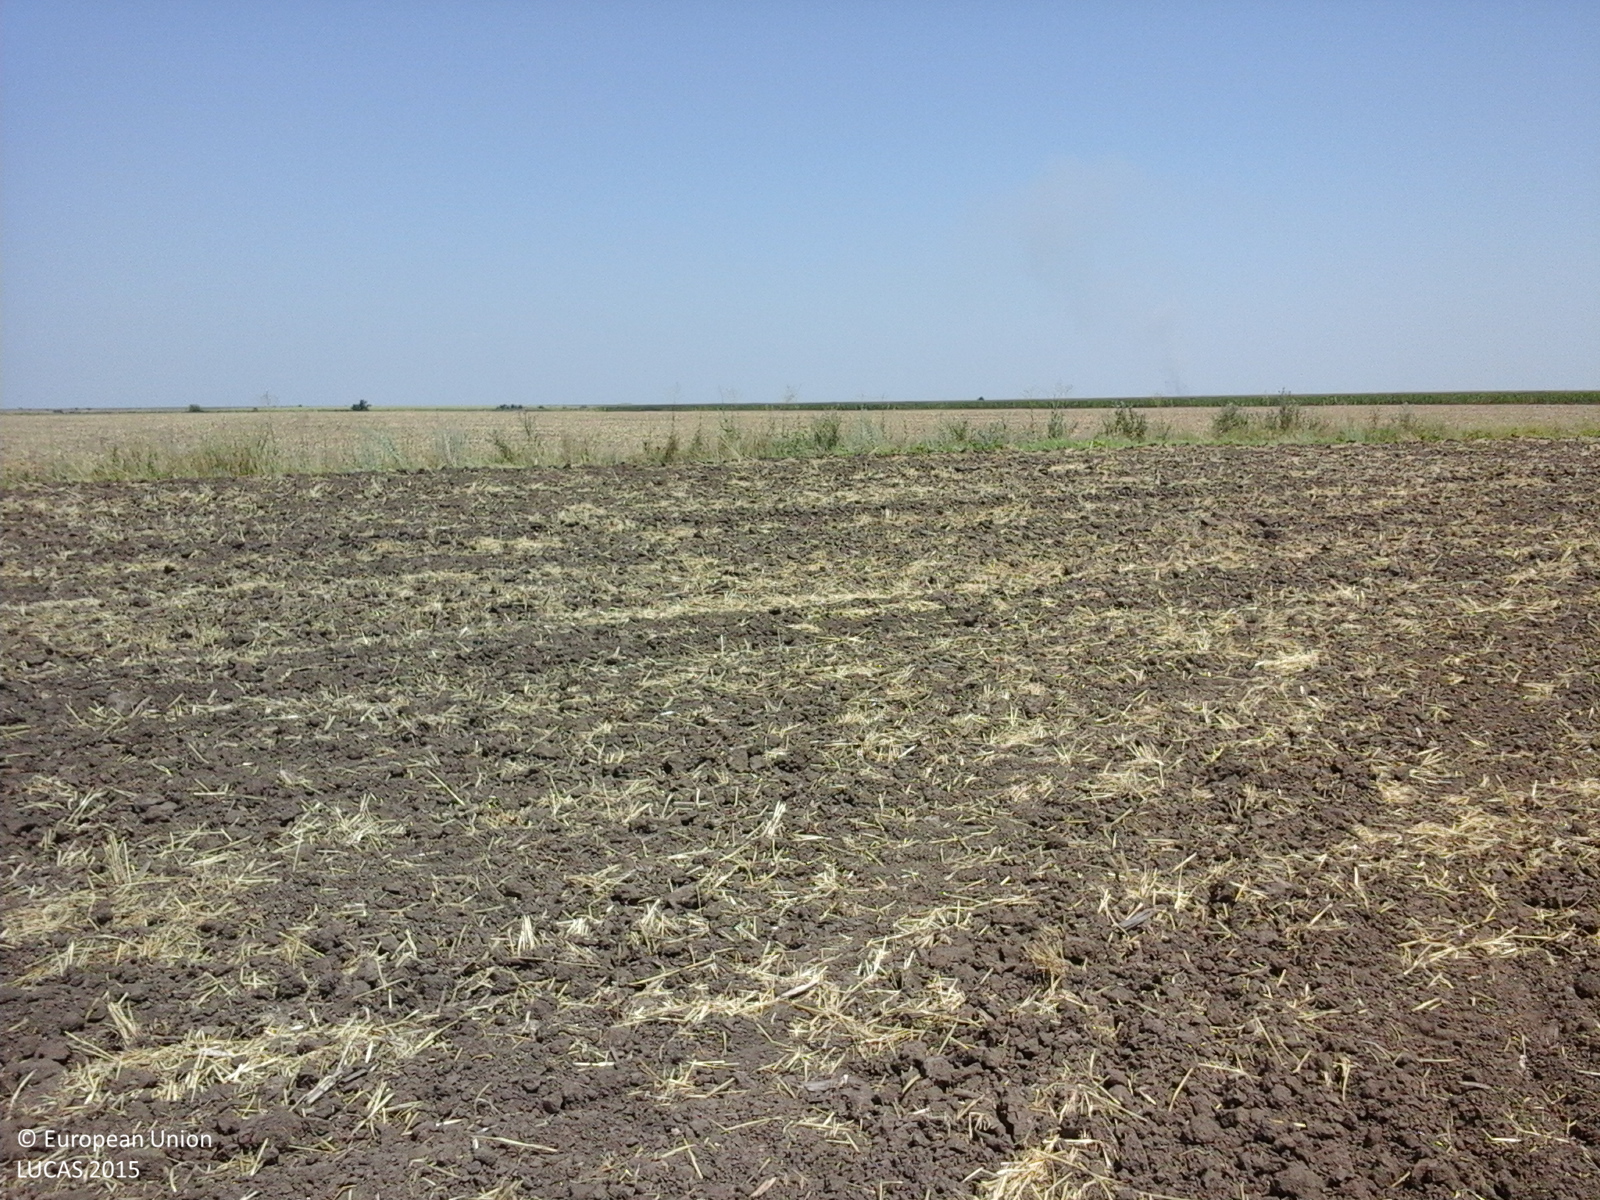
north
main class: Cropland
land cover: Common wheat
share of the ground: < 10 %
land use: Agriculture (excluding fallow land and kitchen gardens)
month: July
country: RO
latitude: 44.2347
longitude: 27.0420
